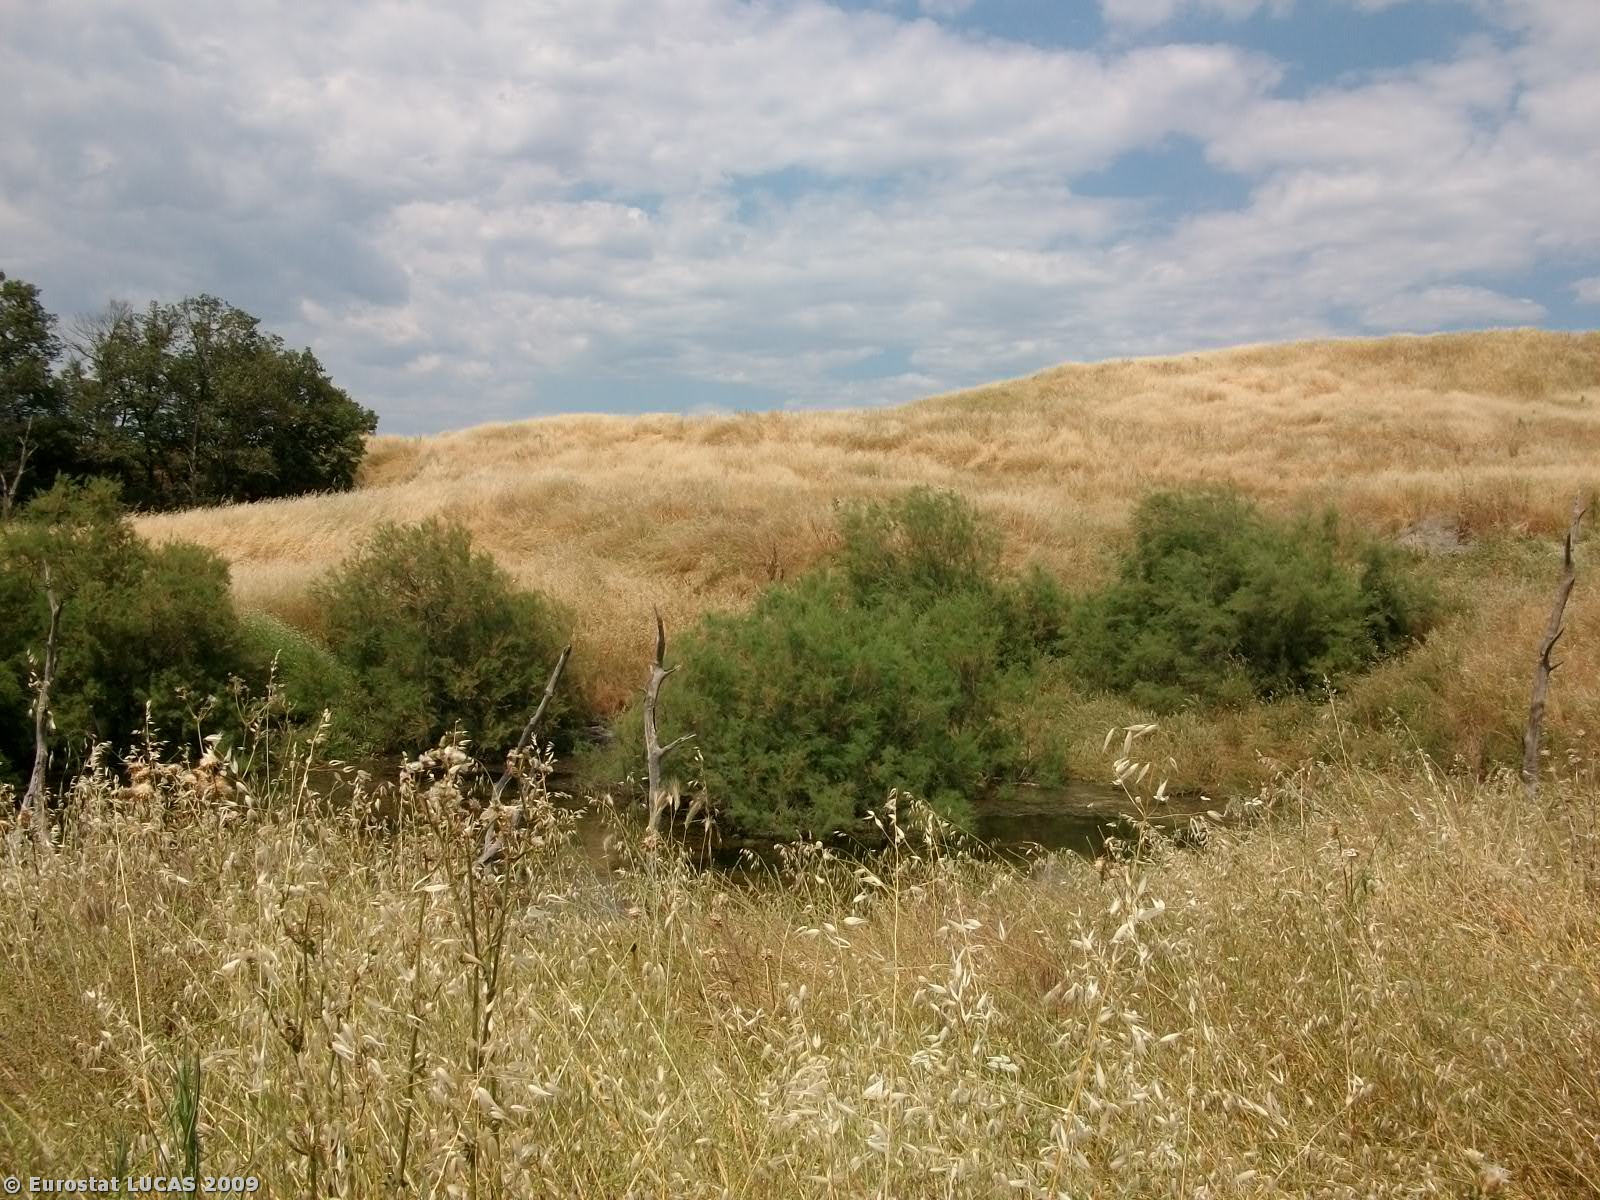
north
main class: Woodland
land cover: Broadleaved woodland
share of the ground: 50 - 75 %
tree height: > 5 m
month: June
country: GR
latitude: 37.3987
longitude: 22.0566
